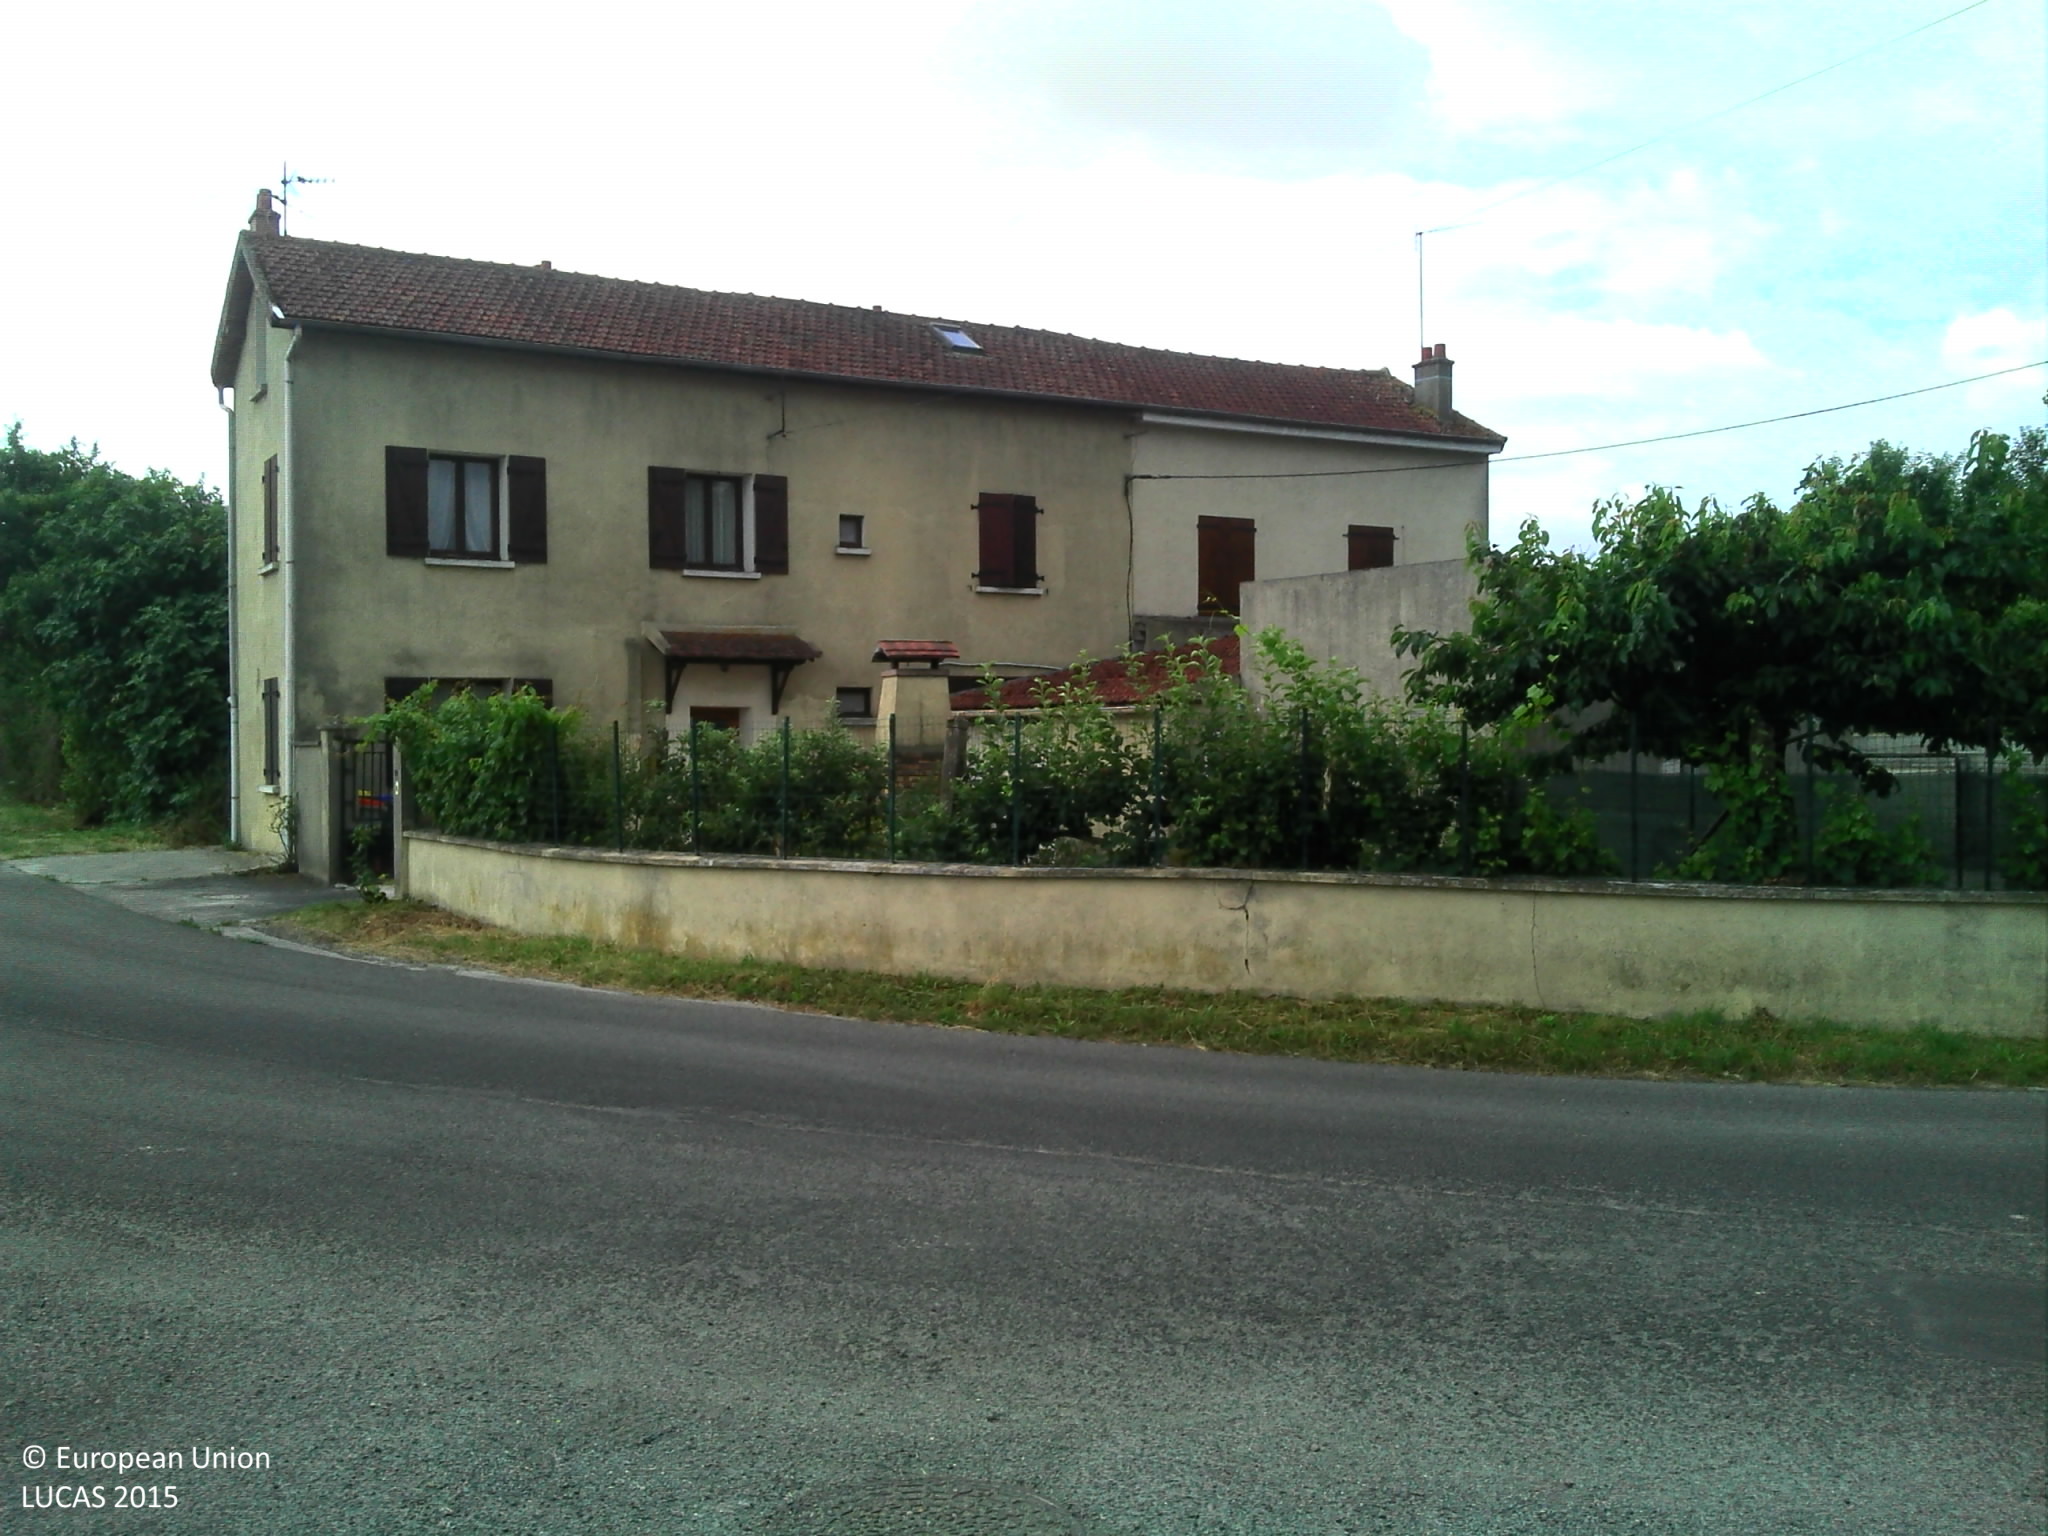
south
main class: Grassland
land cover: Grassland without tree/shrub cover
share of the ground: > 75 %
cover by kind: herbaceous plants 90 %, consolidated bare surface 10 %
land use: Logistics and storage
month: July
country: FR
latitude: 48.6678
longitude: 2.6984
